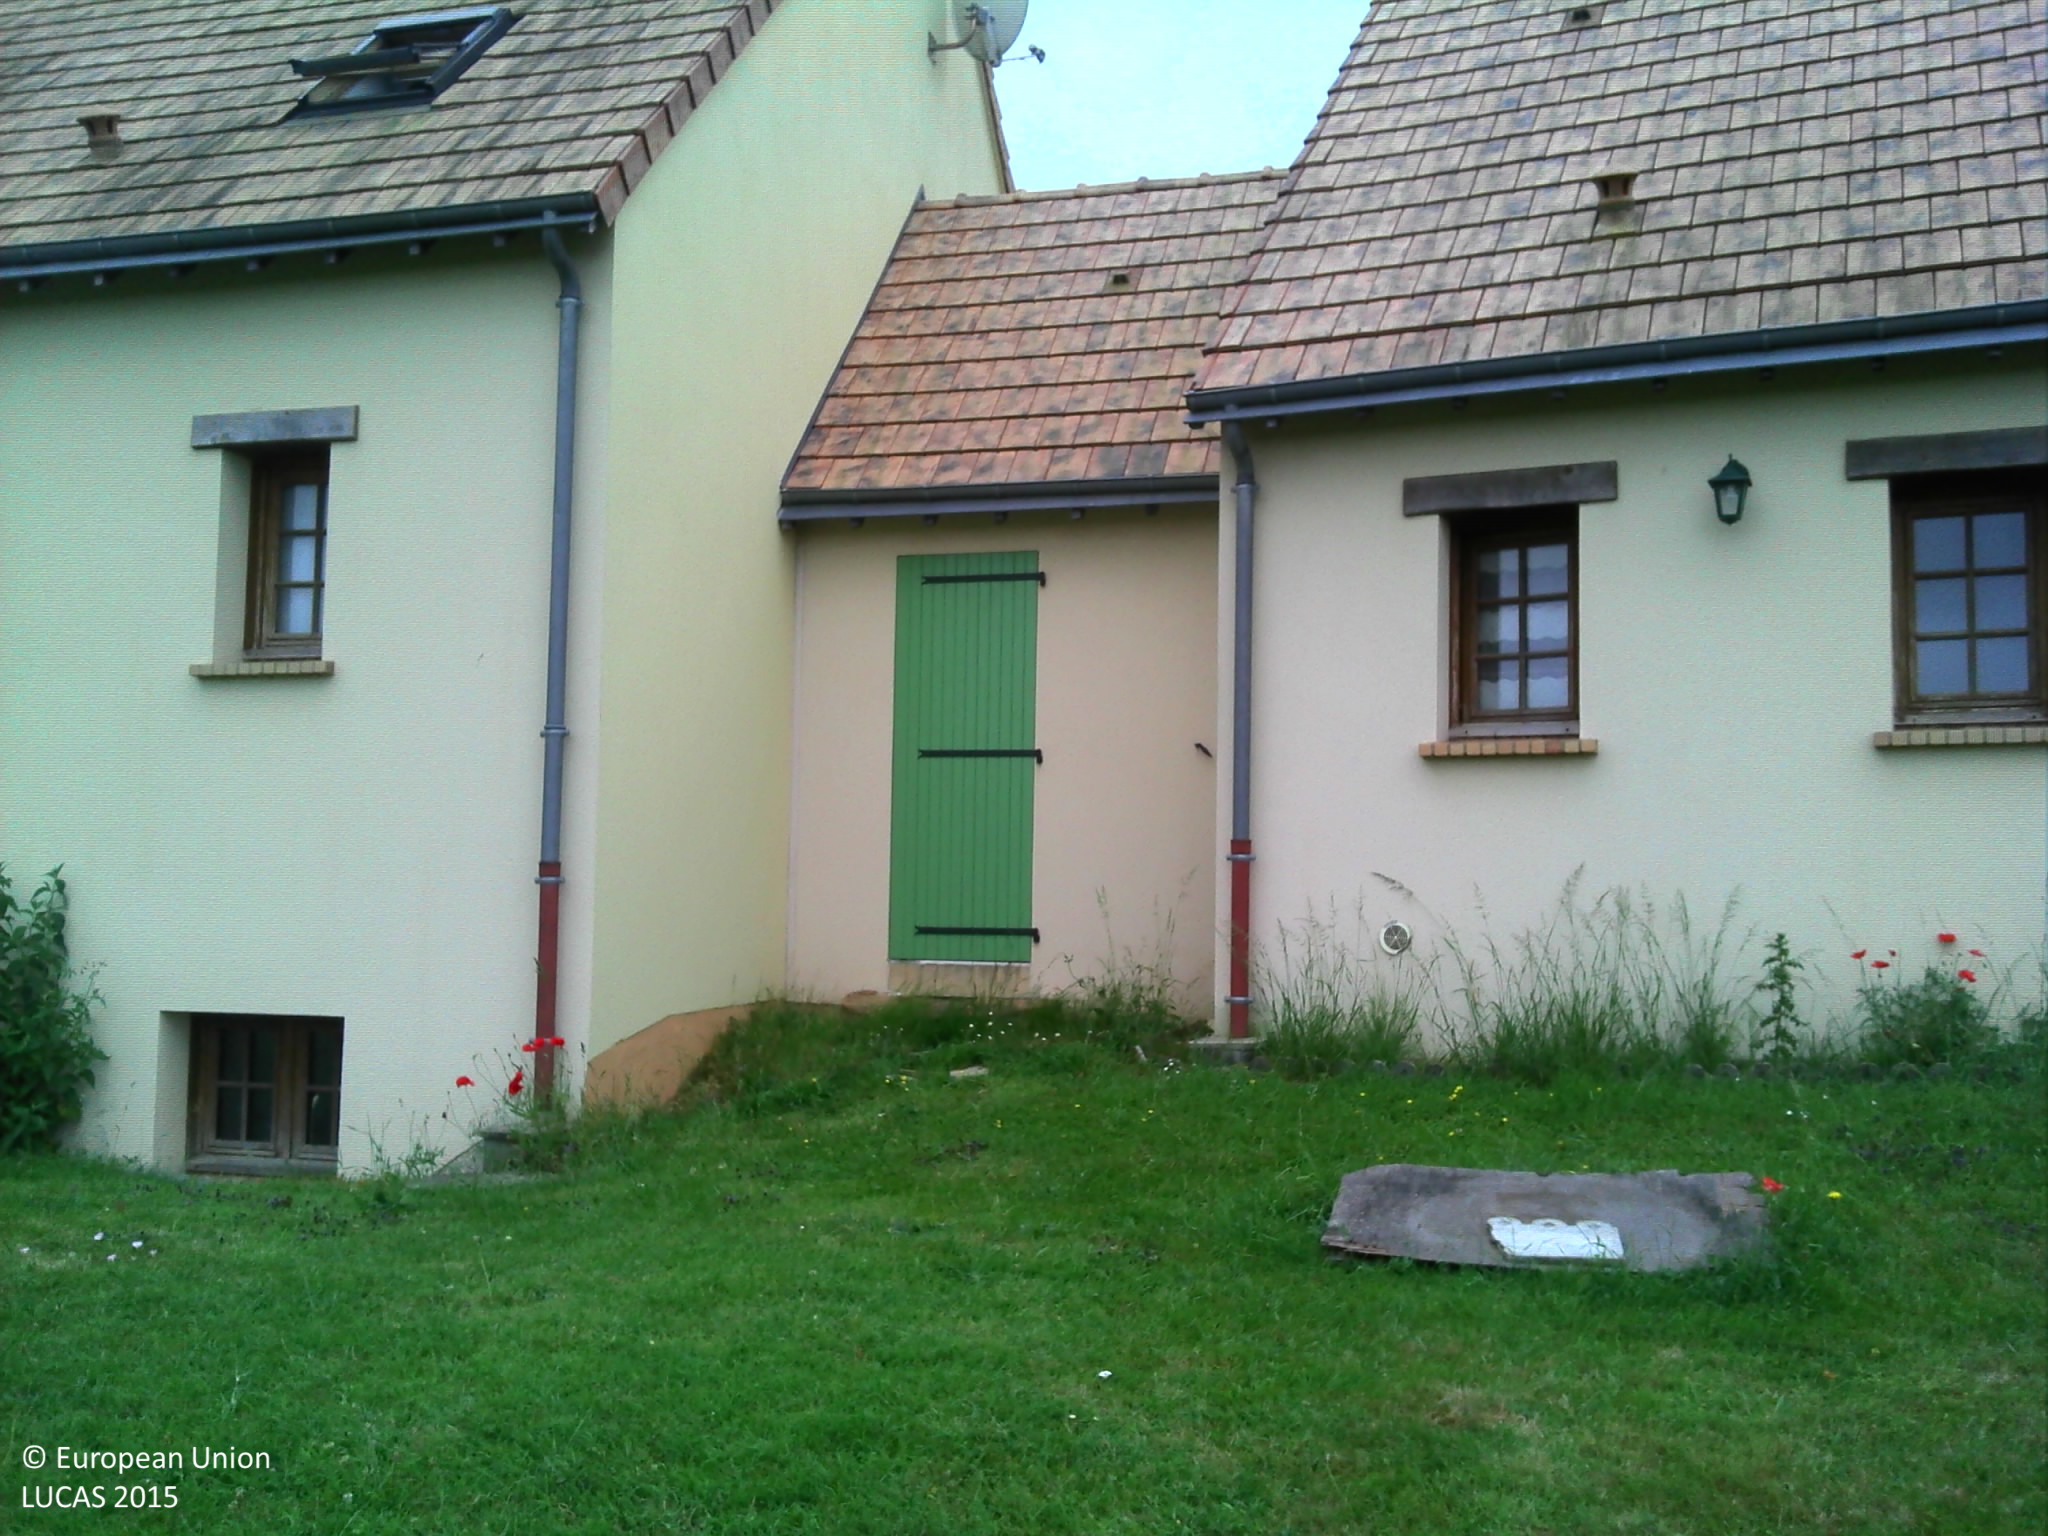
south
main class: Grassland
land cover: Grassland without tree/shrub cover
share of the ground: > 75 %
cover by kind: herbaceous plants 100 %
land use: Agriculture (excluding fallow land and kitchen gardens)
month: June
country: FR
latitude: 48.1129
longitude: 0.2087
